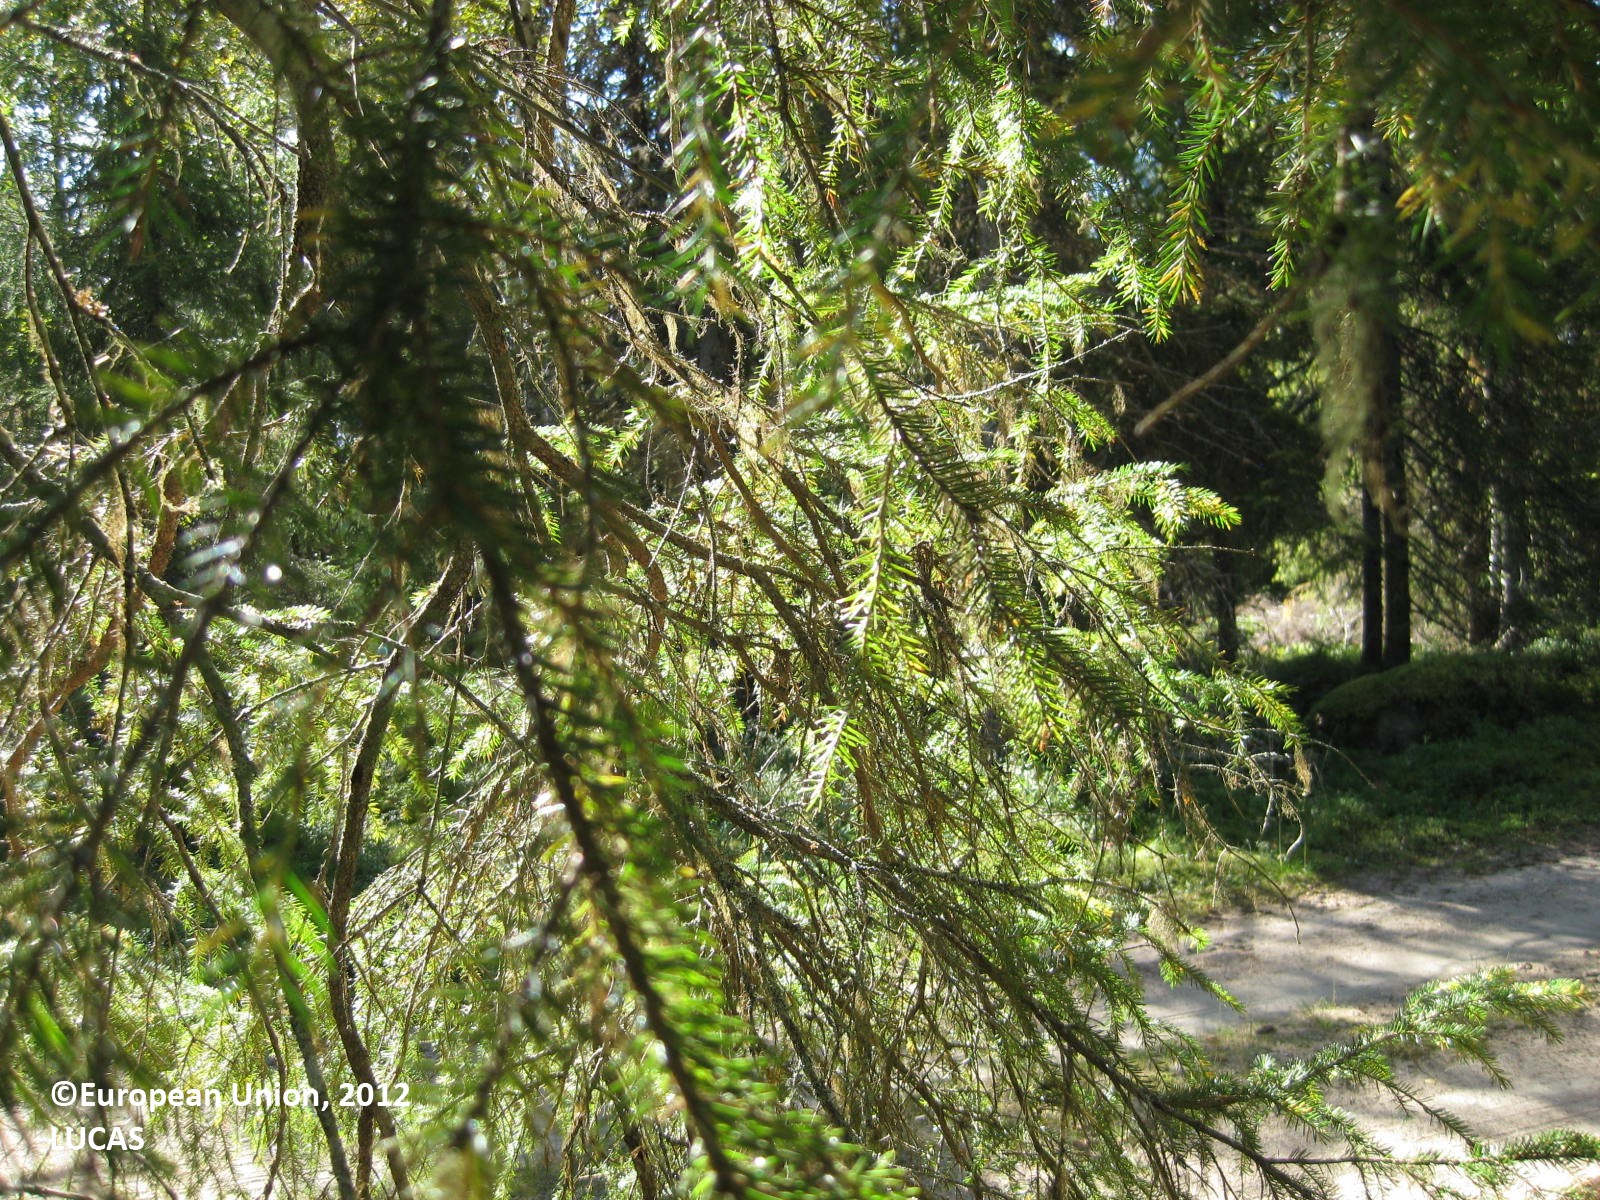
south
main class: Woodland
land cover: Other coniferous woodland
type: boreal forest
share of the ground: 50 - 75 %
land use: Forestry
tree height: > 5 m
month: August
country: FI
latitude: 66.0612
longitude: 29.7913
